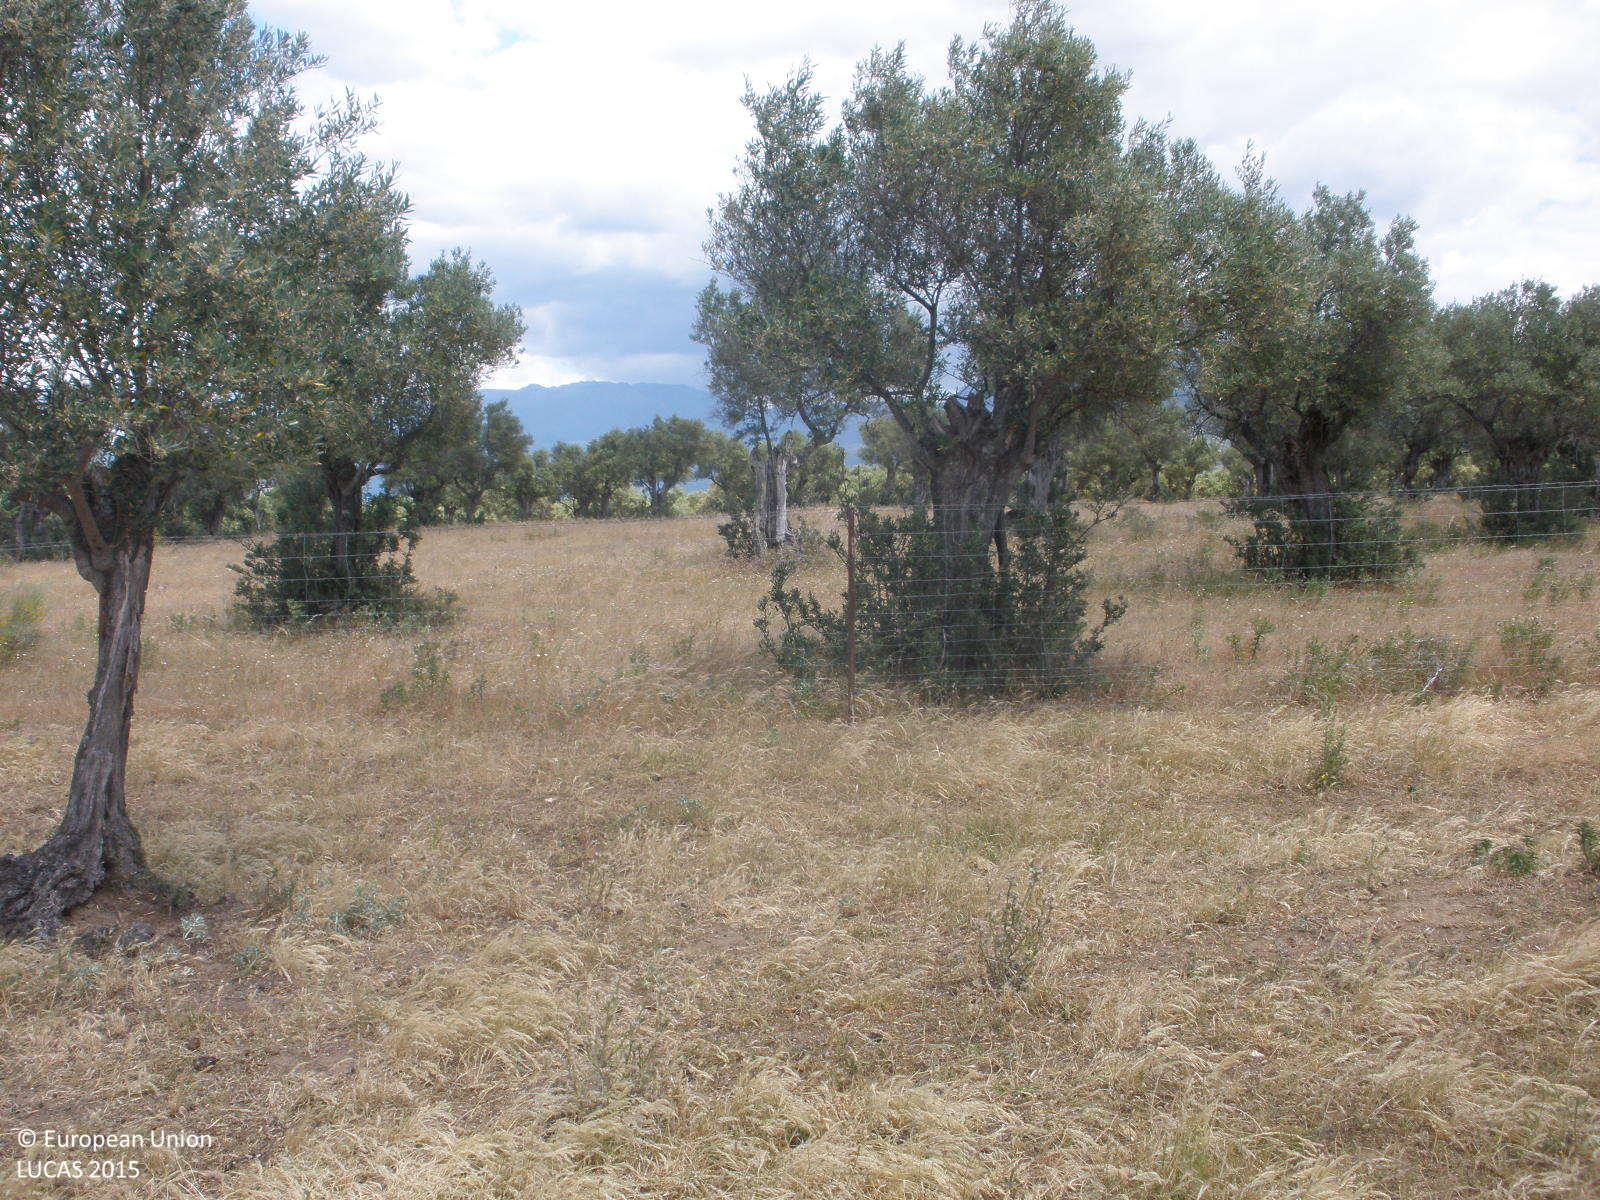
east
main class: Cropland
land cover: Olive groves
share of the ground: 50 - 75 %
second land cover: Grassland without tree/shrub cover
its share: > 75 %
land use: Agriculture (excluding fallow land and kitchen gardens)
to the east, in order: Olive groves; Grassland without tree/shrub cover; Fences; Olive groves; Dry stone walls; Fences; Groves; Grassland without tree/shrub cover
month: May
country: ES
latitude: 40.2543
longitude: -5.9800
